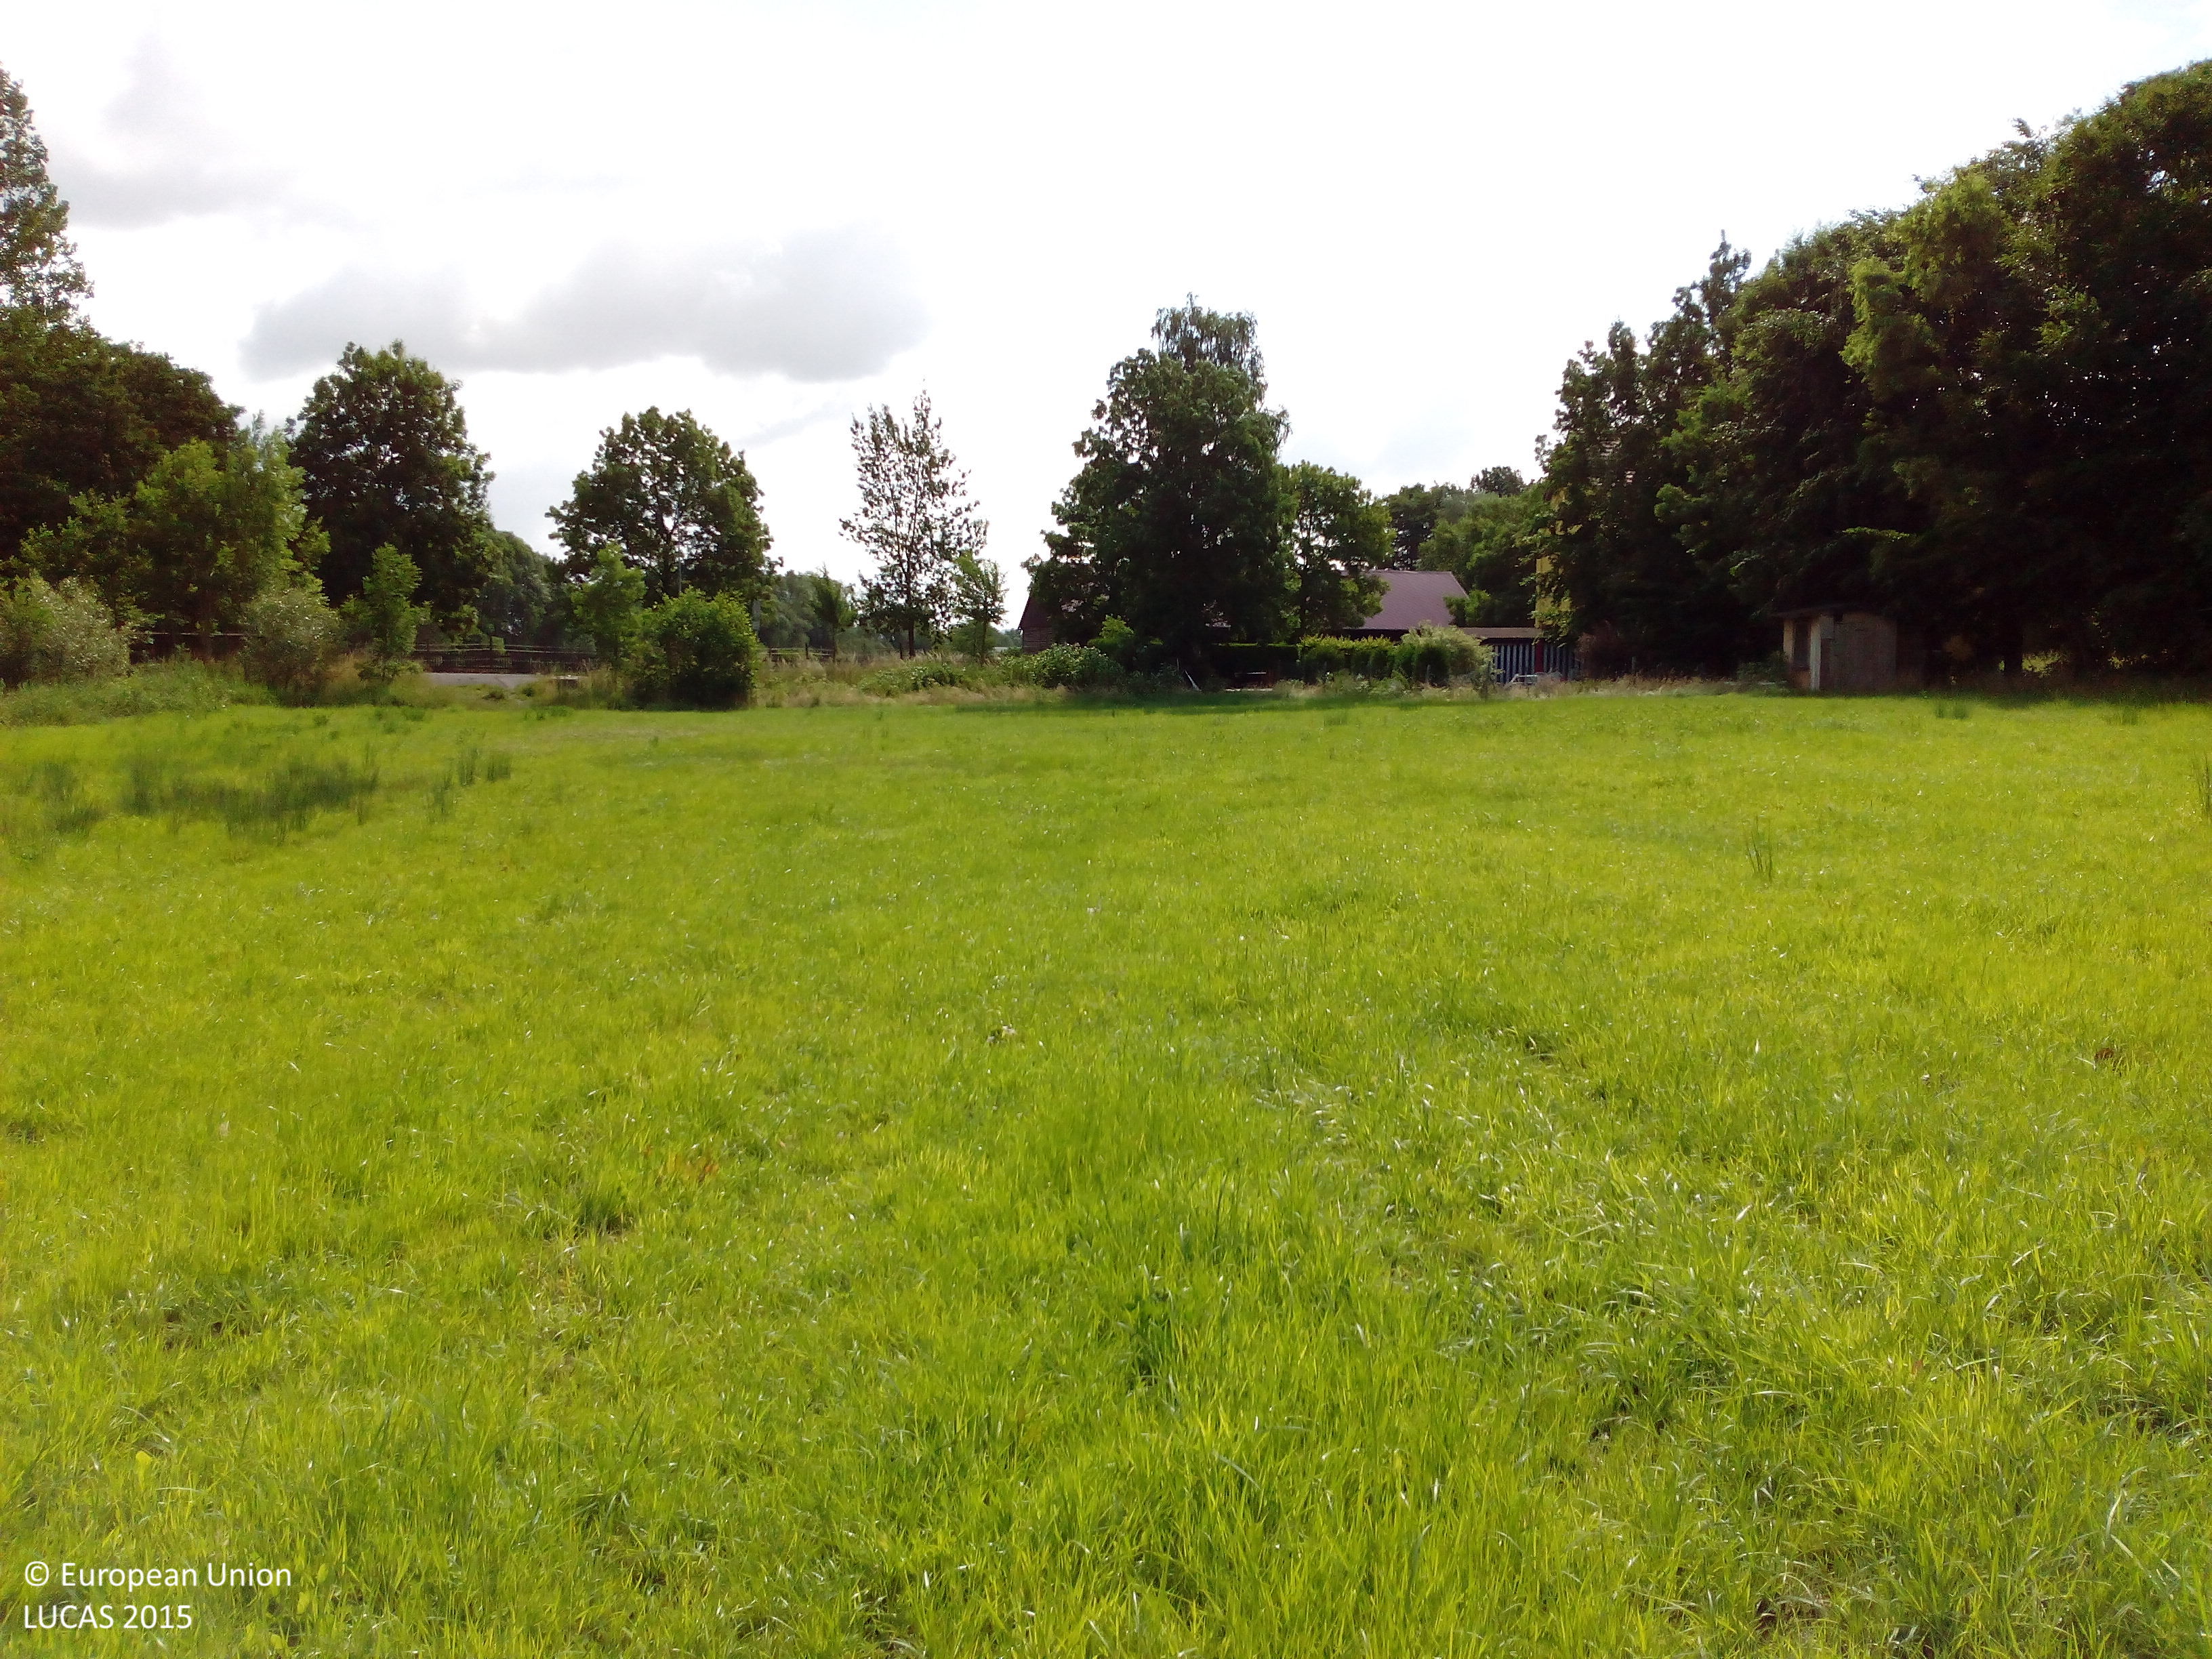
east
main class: Grassland
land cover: Grassland without tree/shrub cover
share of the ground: > 75 %
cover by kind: herbaceous plants 100 %
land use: Agriculture (excluding fallow land and kitchen gardens)
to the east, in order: Grassland without tree/shrub cover; Shruby margins; Abandoned hedges; Grass margins; Paved roads, cycling and walking lanes; Fences; Lines of trees; Grass margins; Fences; Grassland without tree/shrub cover; Fences; Grassland without tree/shrub cover
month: July
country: DE
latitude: 51.6404
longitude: 9.8700
